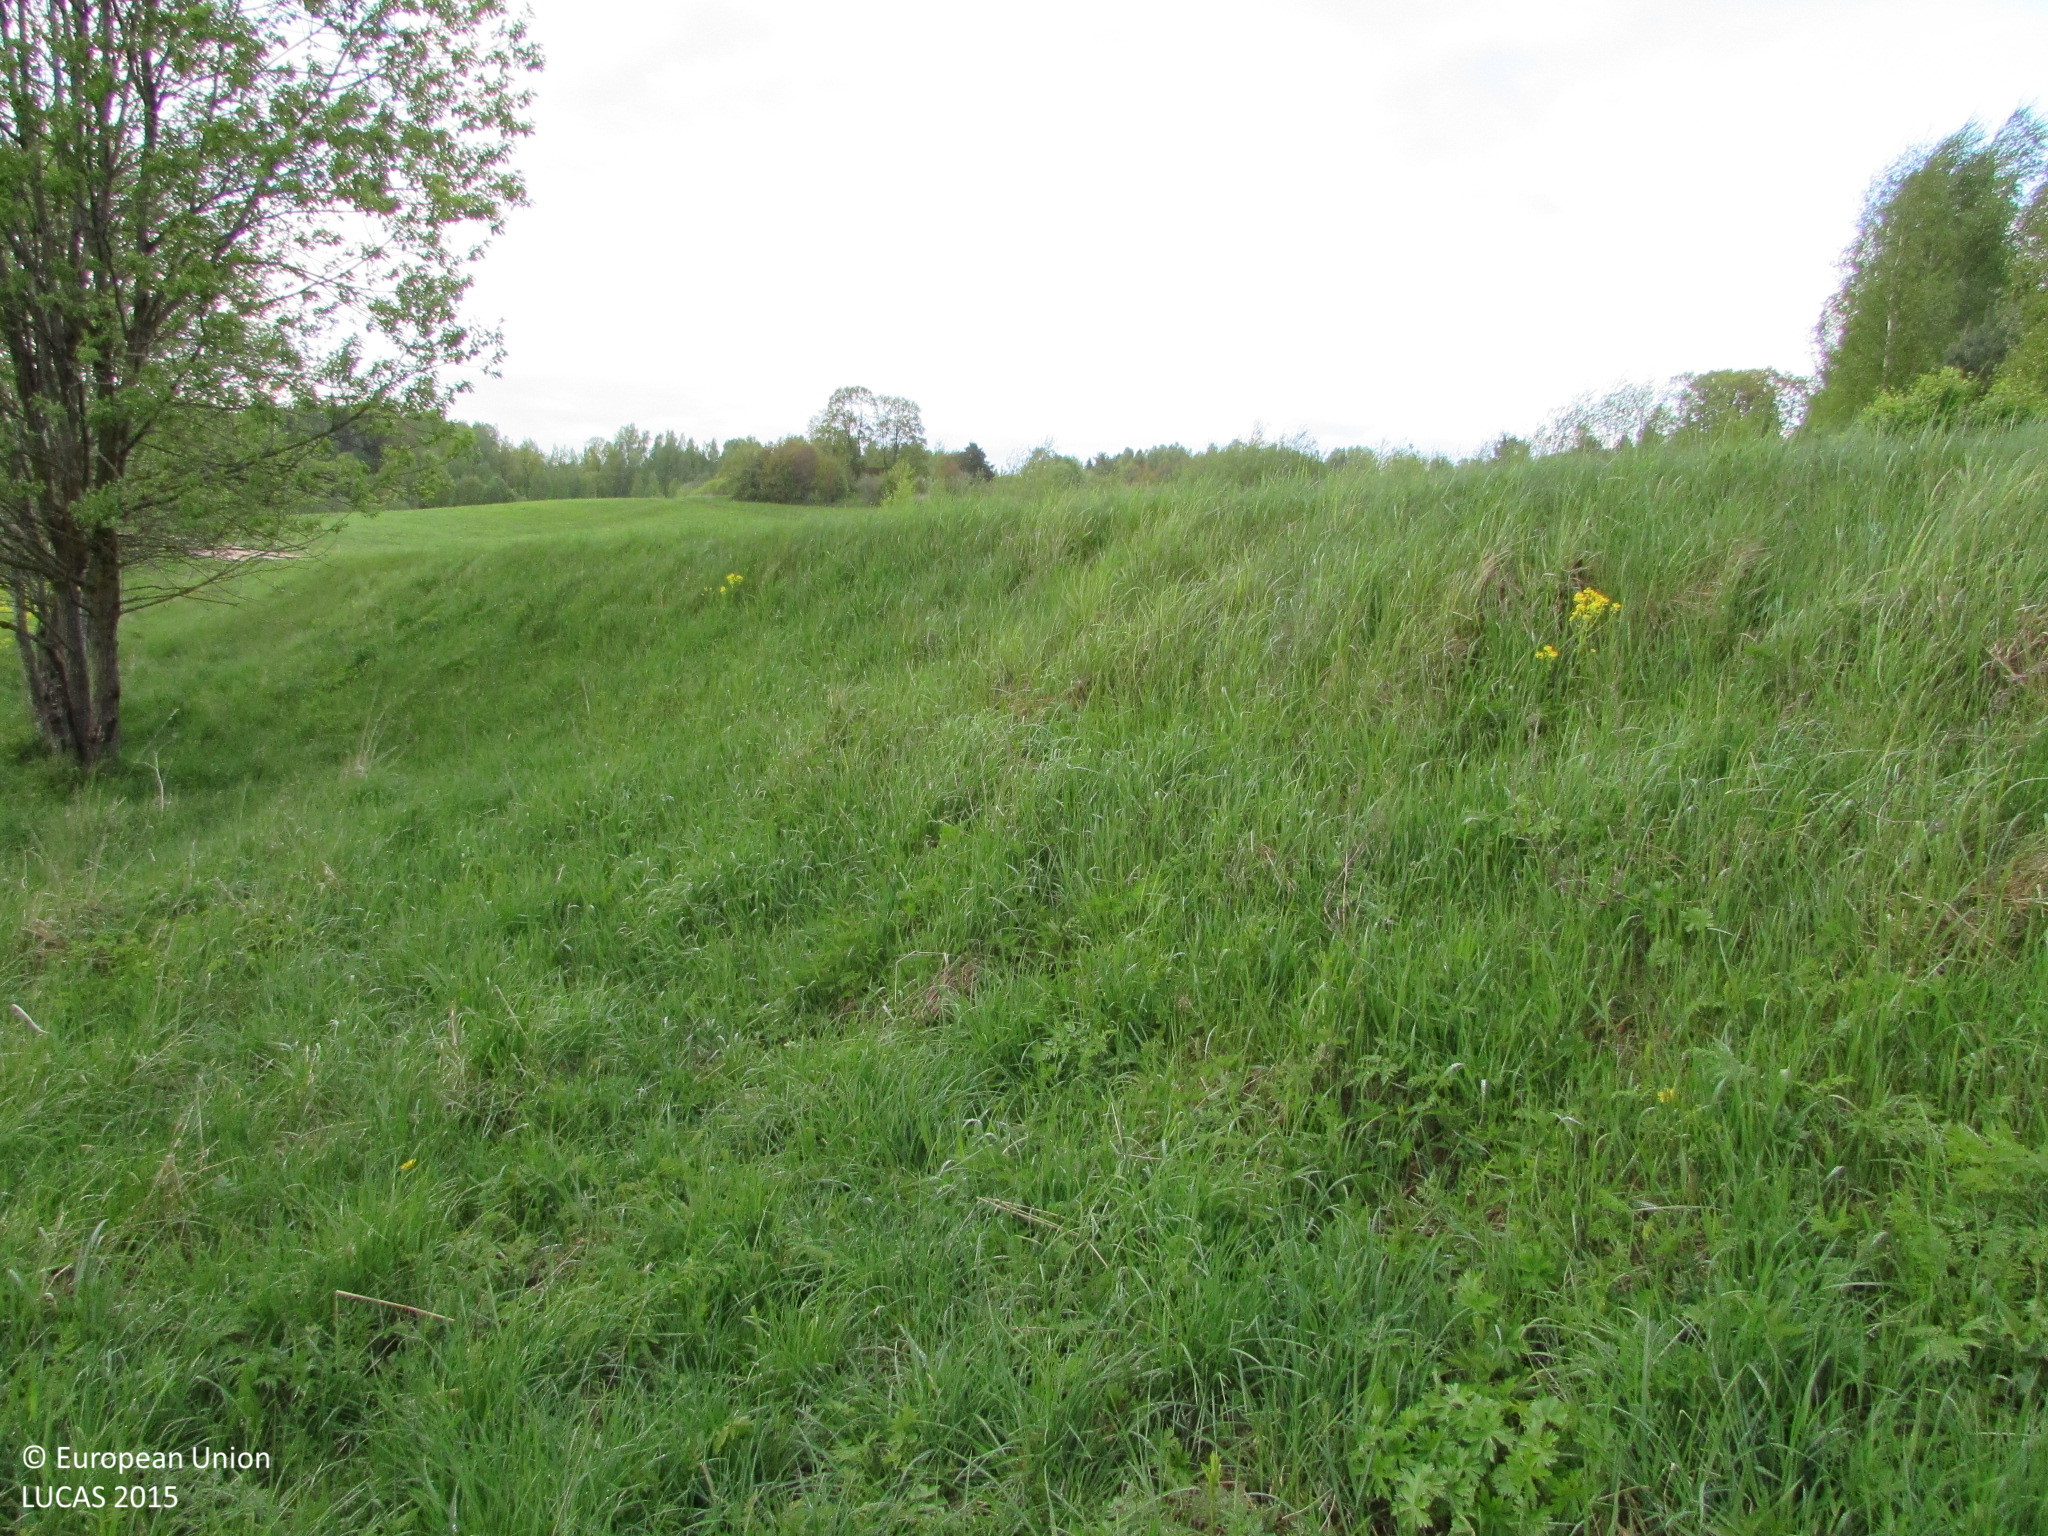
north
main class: Grassland
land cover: Grassland without tree/shrub cover
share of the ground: > 75 %
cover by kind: herbaceous plants 95 %, unconsolidated bare surface 5 %
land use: Agriculture (excluding fallow land and kitchen gardens)
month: May
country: LV
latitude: 56.2270
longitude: 27.2203
